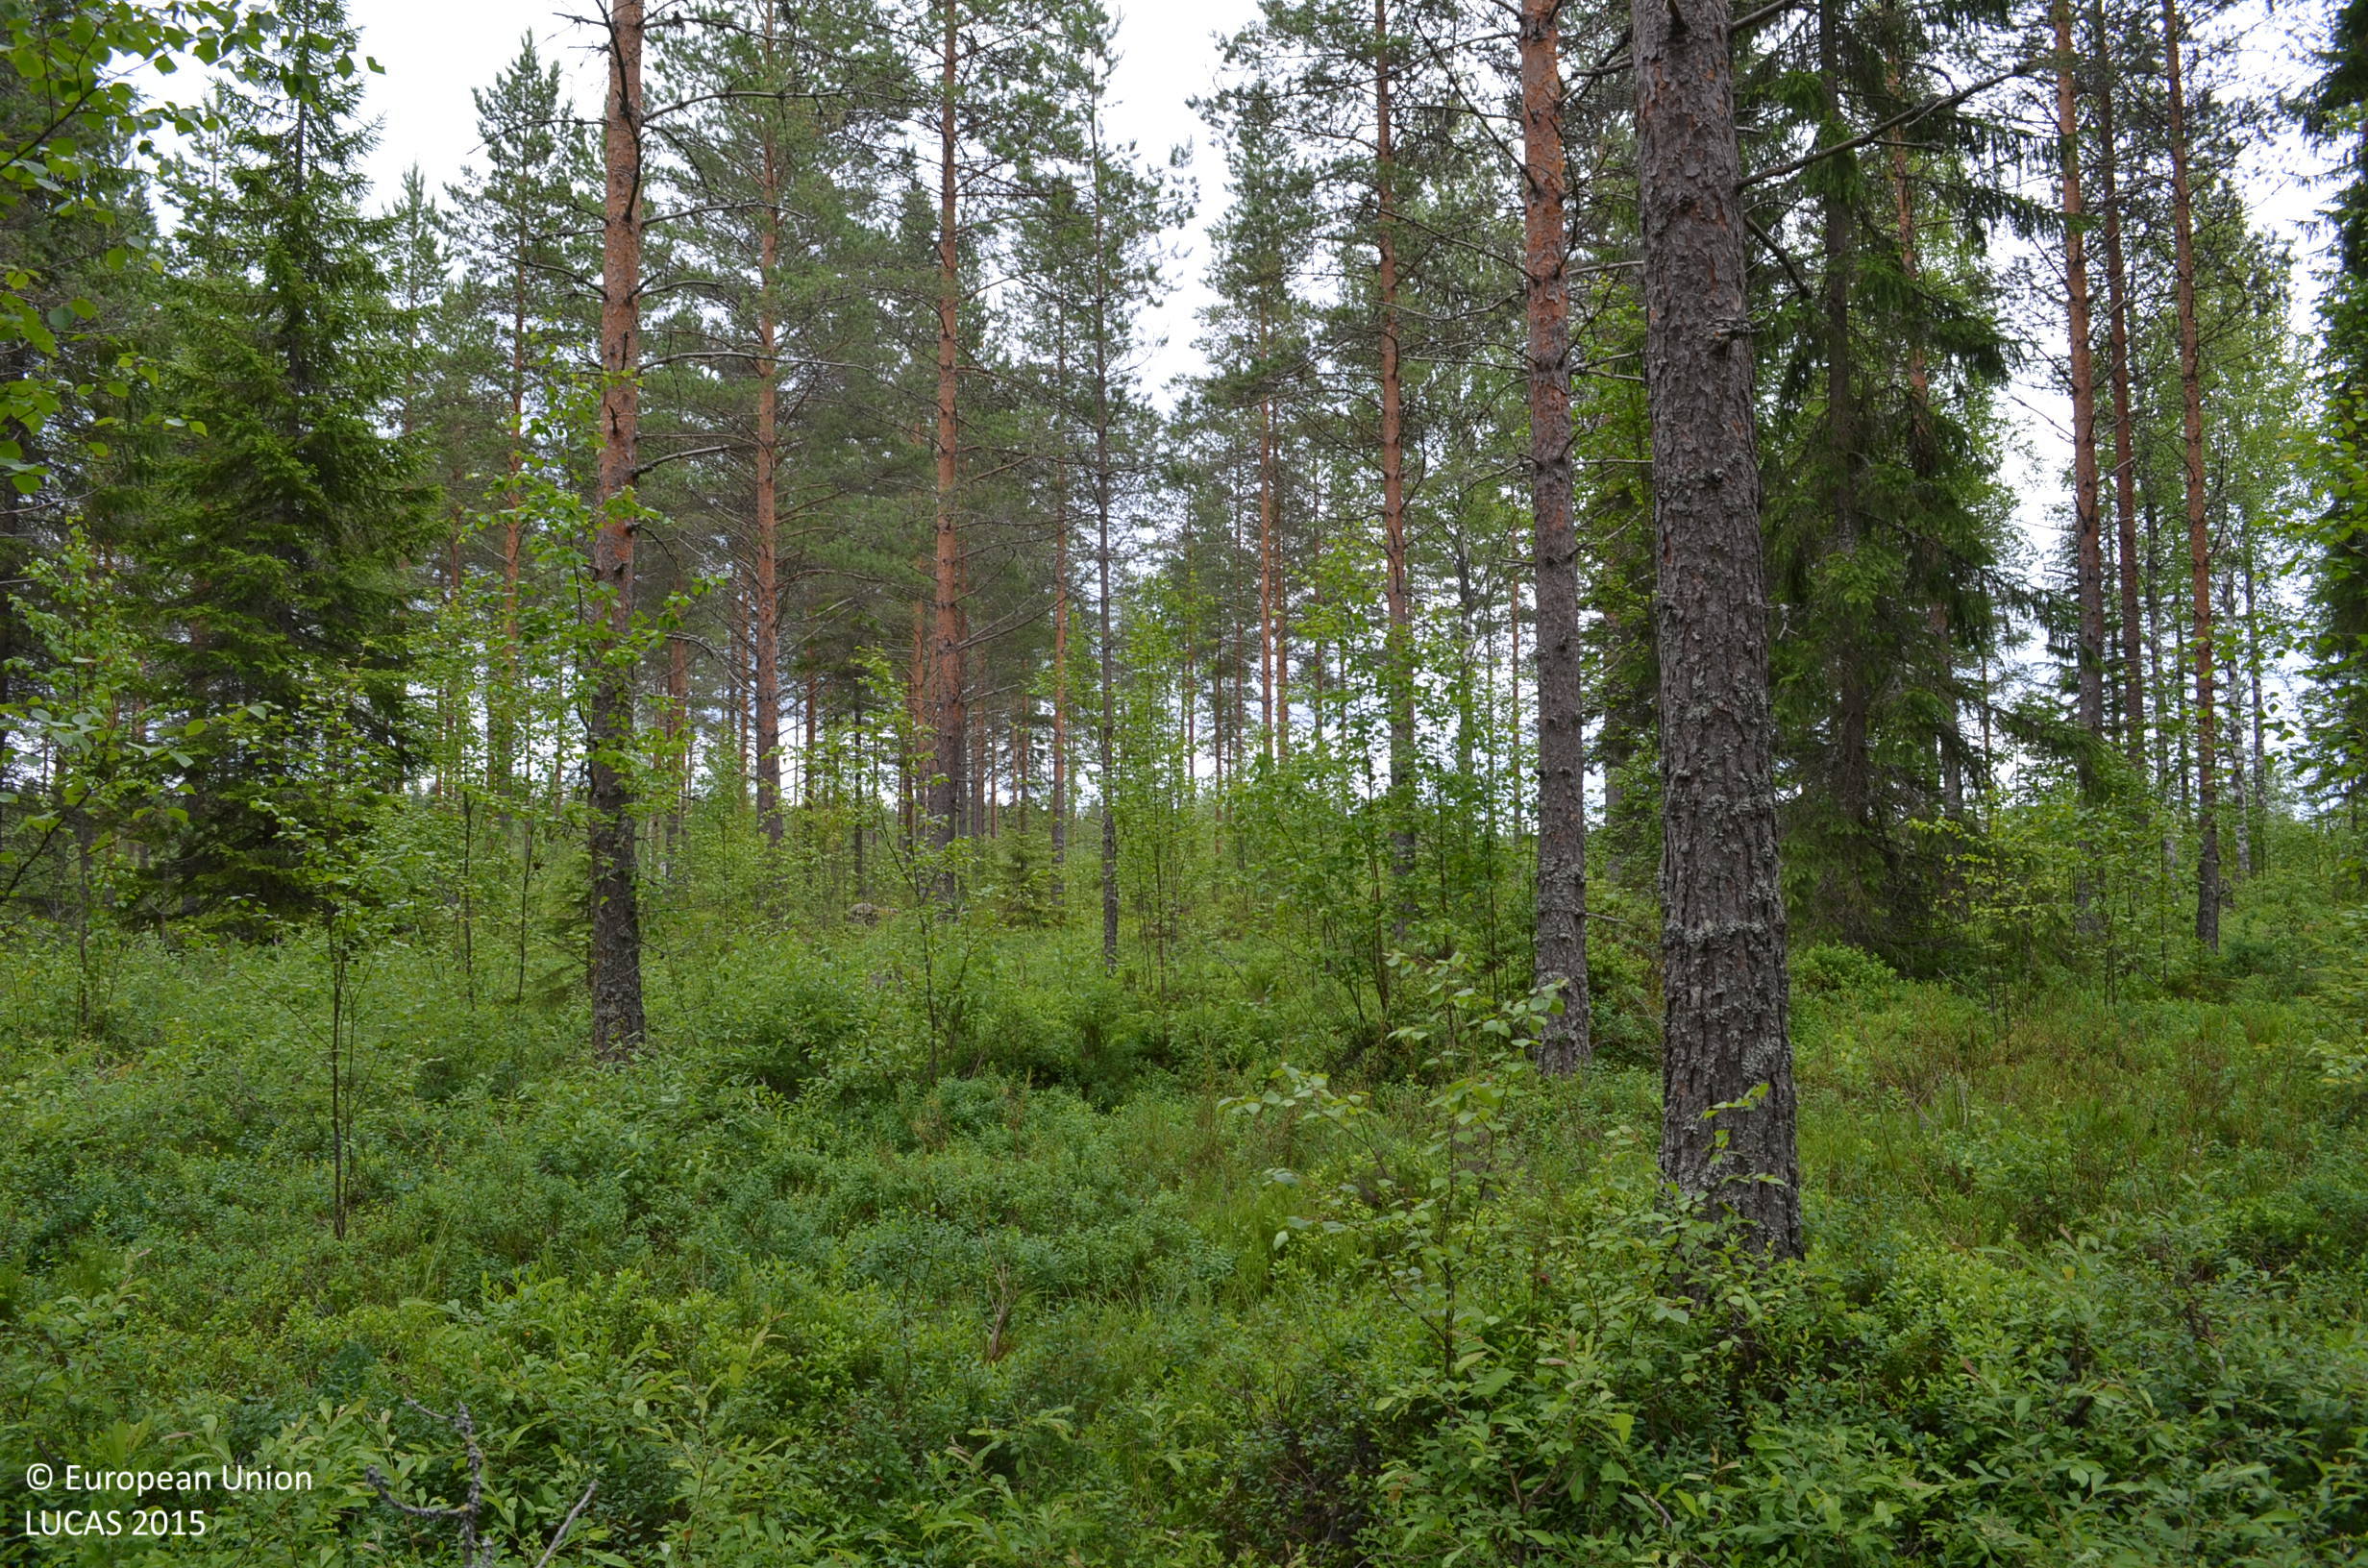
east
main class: Woodland
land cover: Pine dominated coniferous woodland
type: boreal forest
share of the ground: 50 - 75 %
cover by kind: coniferous forest trees 55 %, shrubs 35 %, broadleaved forest trees 10 %
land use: Forestry
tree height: > 5 m
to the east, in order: Pine dominated coniferous woodland; Shrubland with sparse tree cover; Shruby margins; Tracks; Shruby margins; Ditches and canals; Pine dominated coniferous woodland
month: July
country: FI
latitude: 62.2722
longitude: 23.5405
